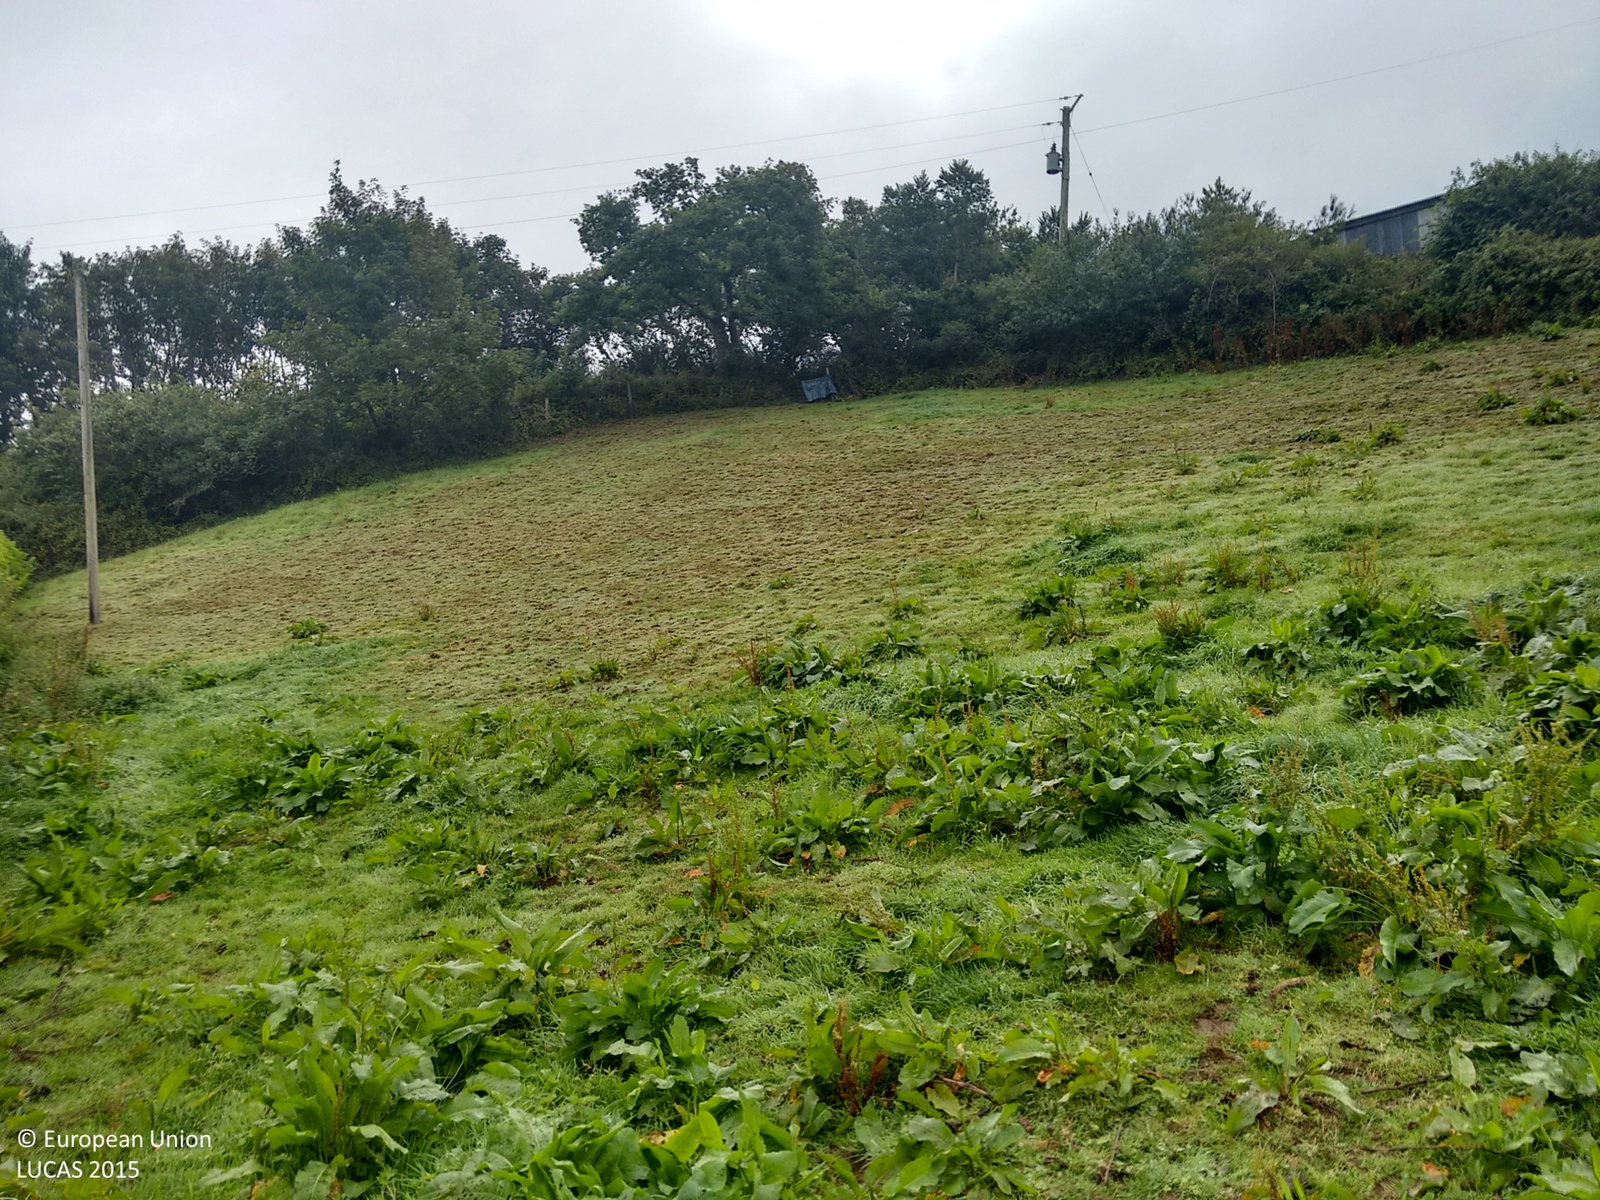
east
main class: Shrubland
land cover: Shrubland without tree cover
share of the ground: > 75 %
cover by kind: shrubs 100 %
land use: Semi-natural and natural areas not in use
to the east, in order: Shrubland without tree cover; Artificial constructions in urban areas; Broadleaved woodland; Fences; Grassland without tree/shrub cover; Fences; Broadleaved woodland
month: August
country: GB
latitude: 50.3604
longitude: -4.2540
